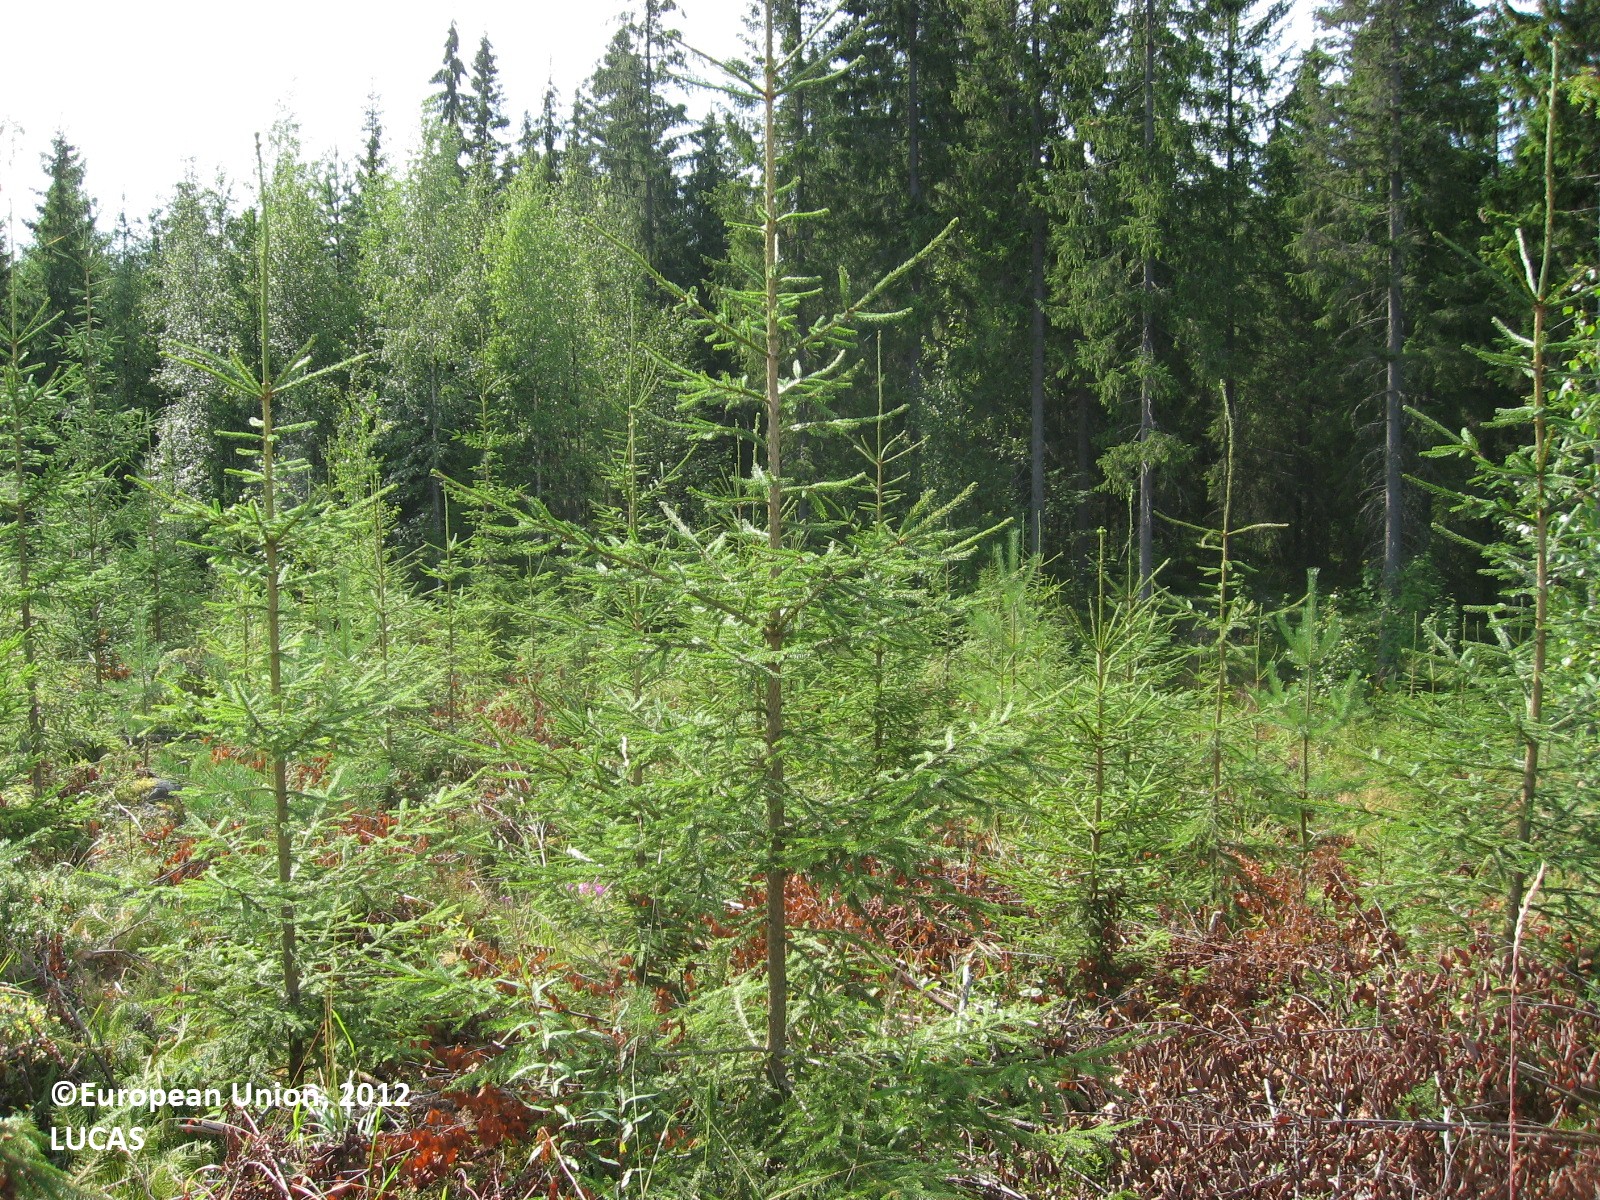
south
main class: Woodland
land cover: Spruce dominated coniferous woodland
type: boreal forest
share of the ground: 25 - 50 %
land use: Forestry
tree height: < 5 m
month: August
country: FI
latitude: 61.5816
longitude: 24.9697
